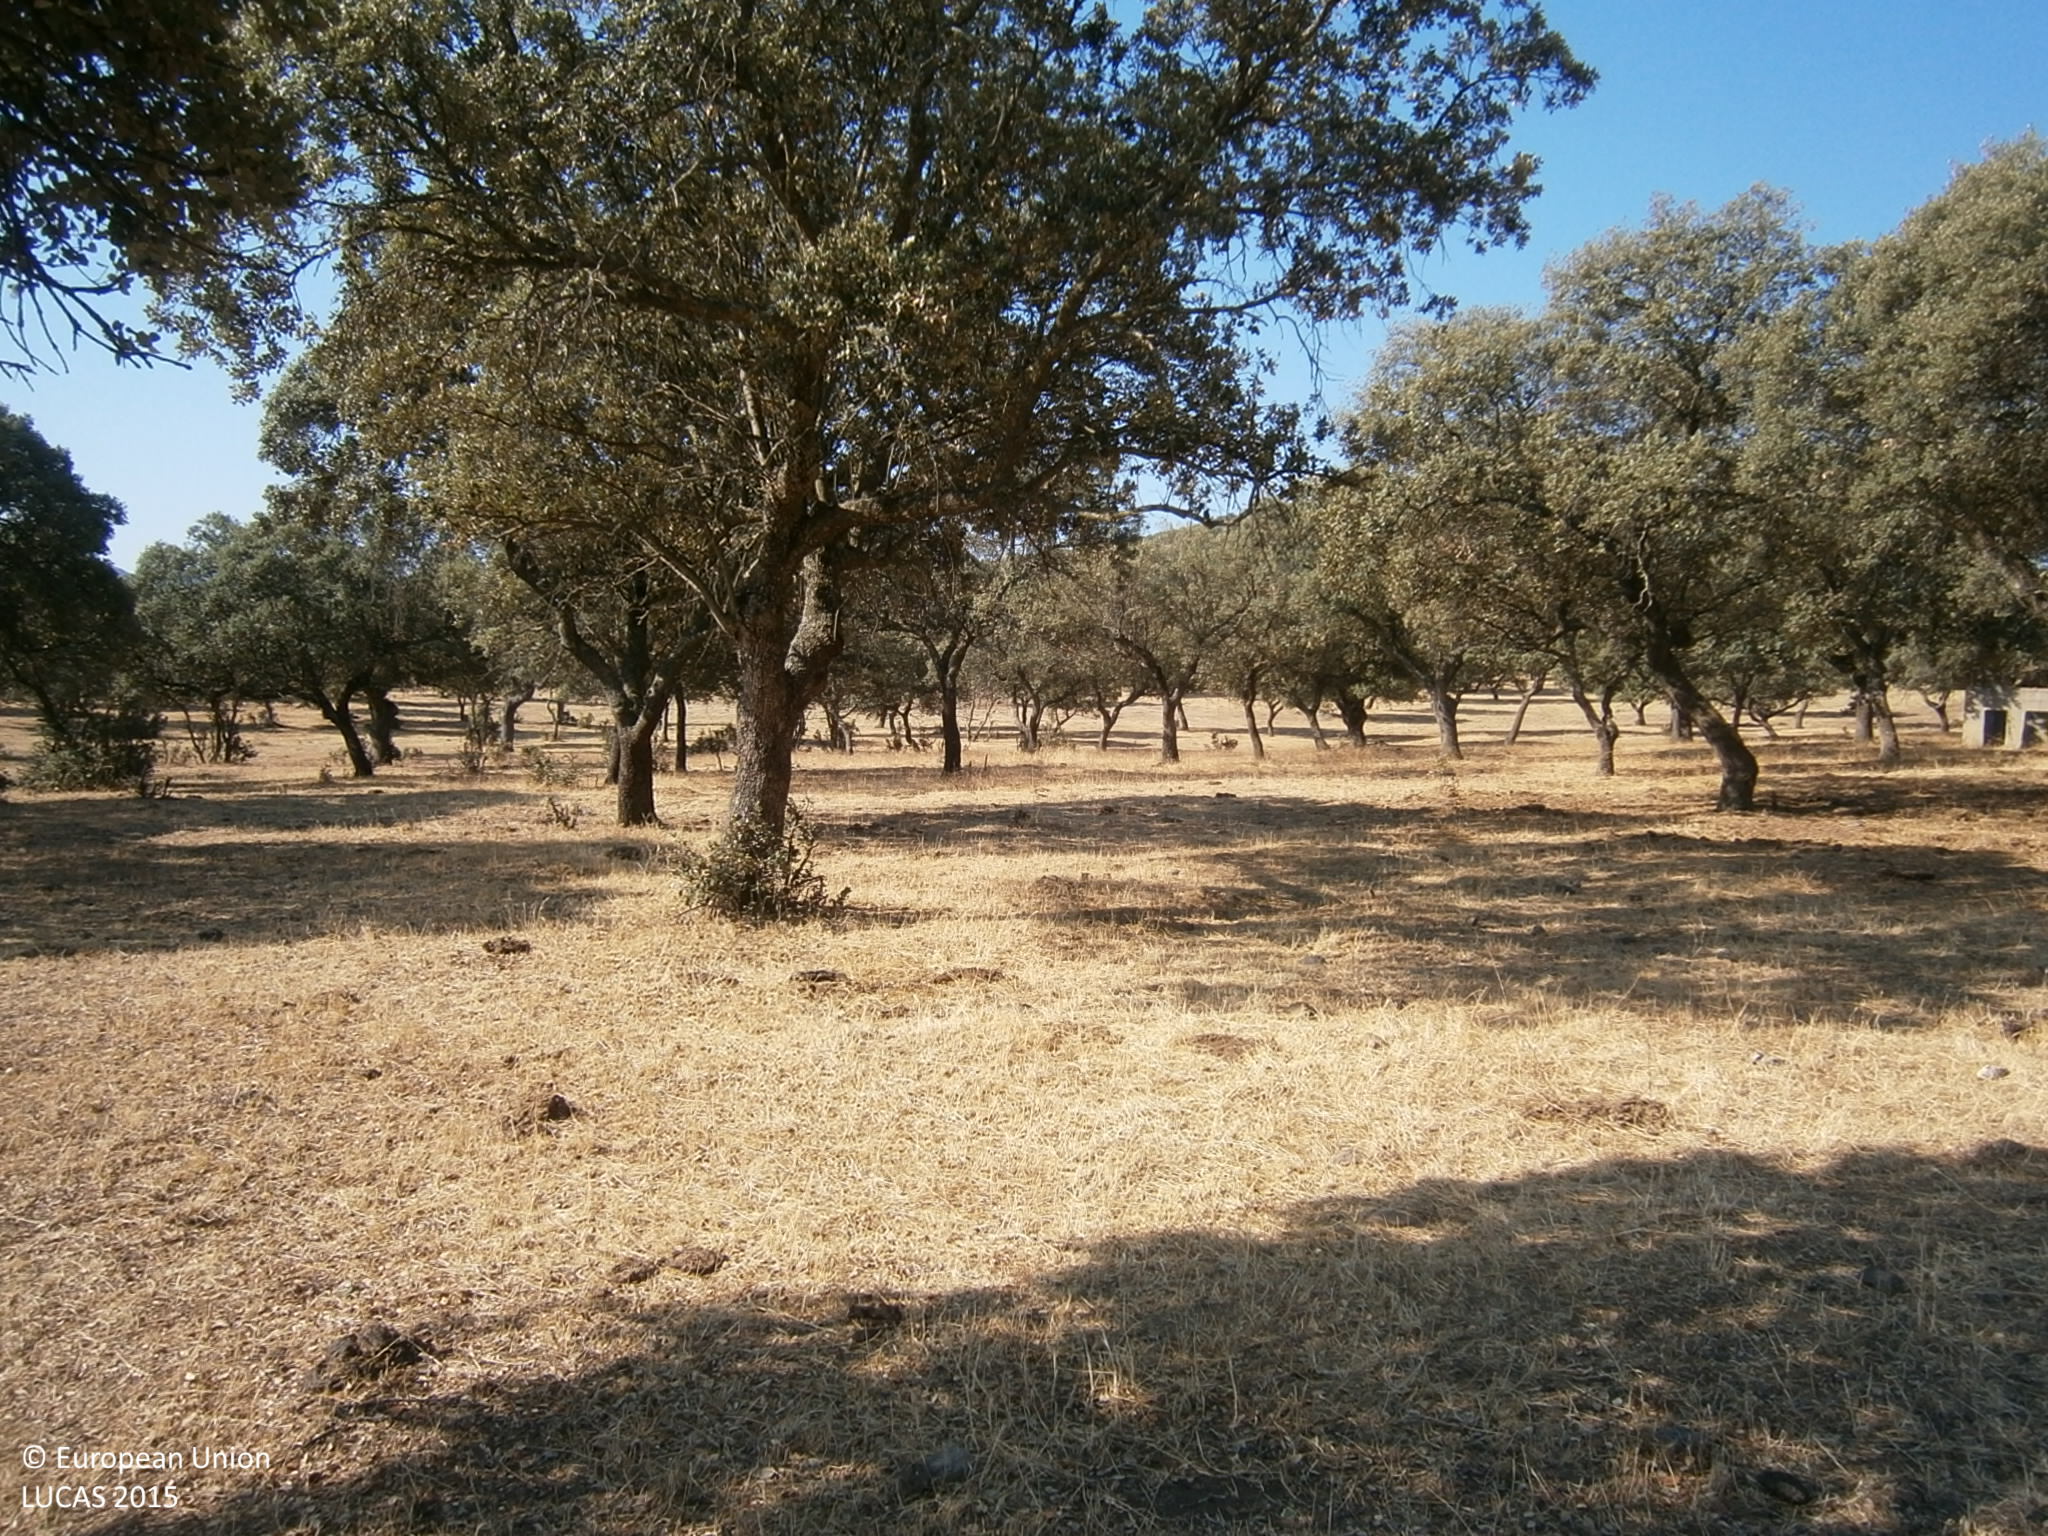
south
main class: Woodland
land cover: Broadleaved woodland
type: broadleaved evergreen forest
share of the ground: > 75 %
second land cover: Spontaneously vegetated surfaces
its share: > 75 %
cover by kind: broadleaved forest trees 90 %, unconsolidated bare surface 5 %
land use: Forestry
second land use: Agriculture (excluding fallow land and kitchen gardens)
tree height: > 5 m
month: June
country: ES
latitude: 38.5565
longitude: -6.7561
